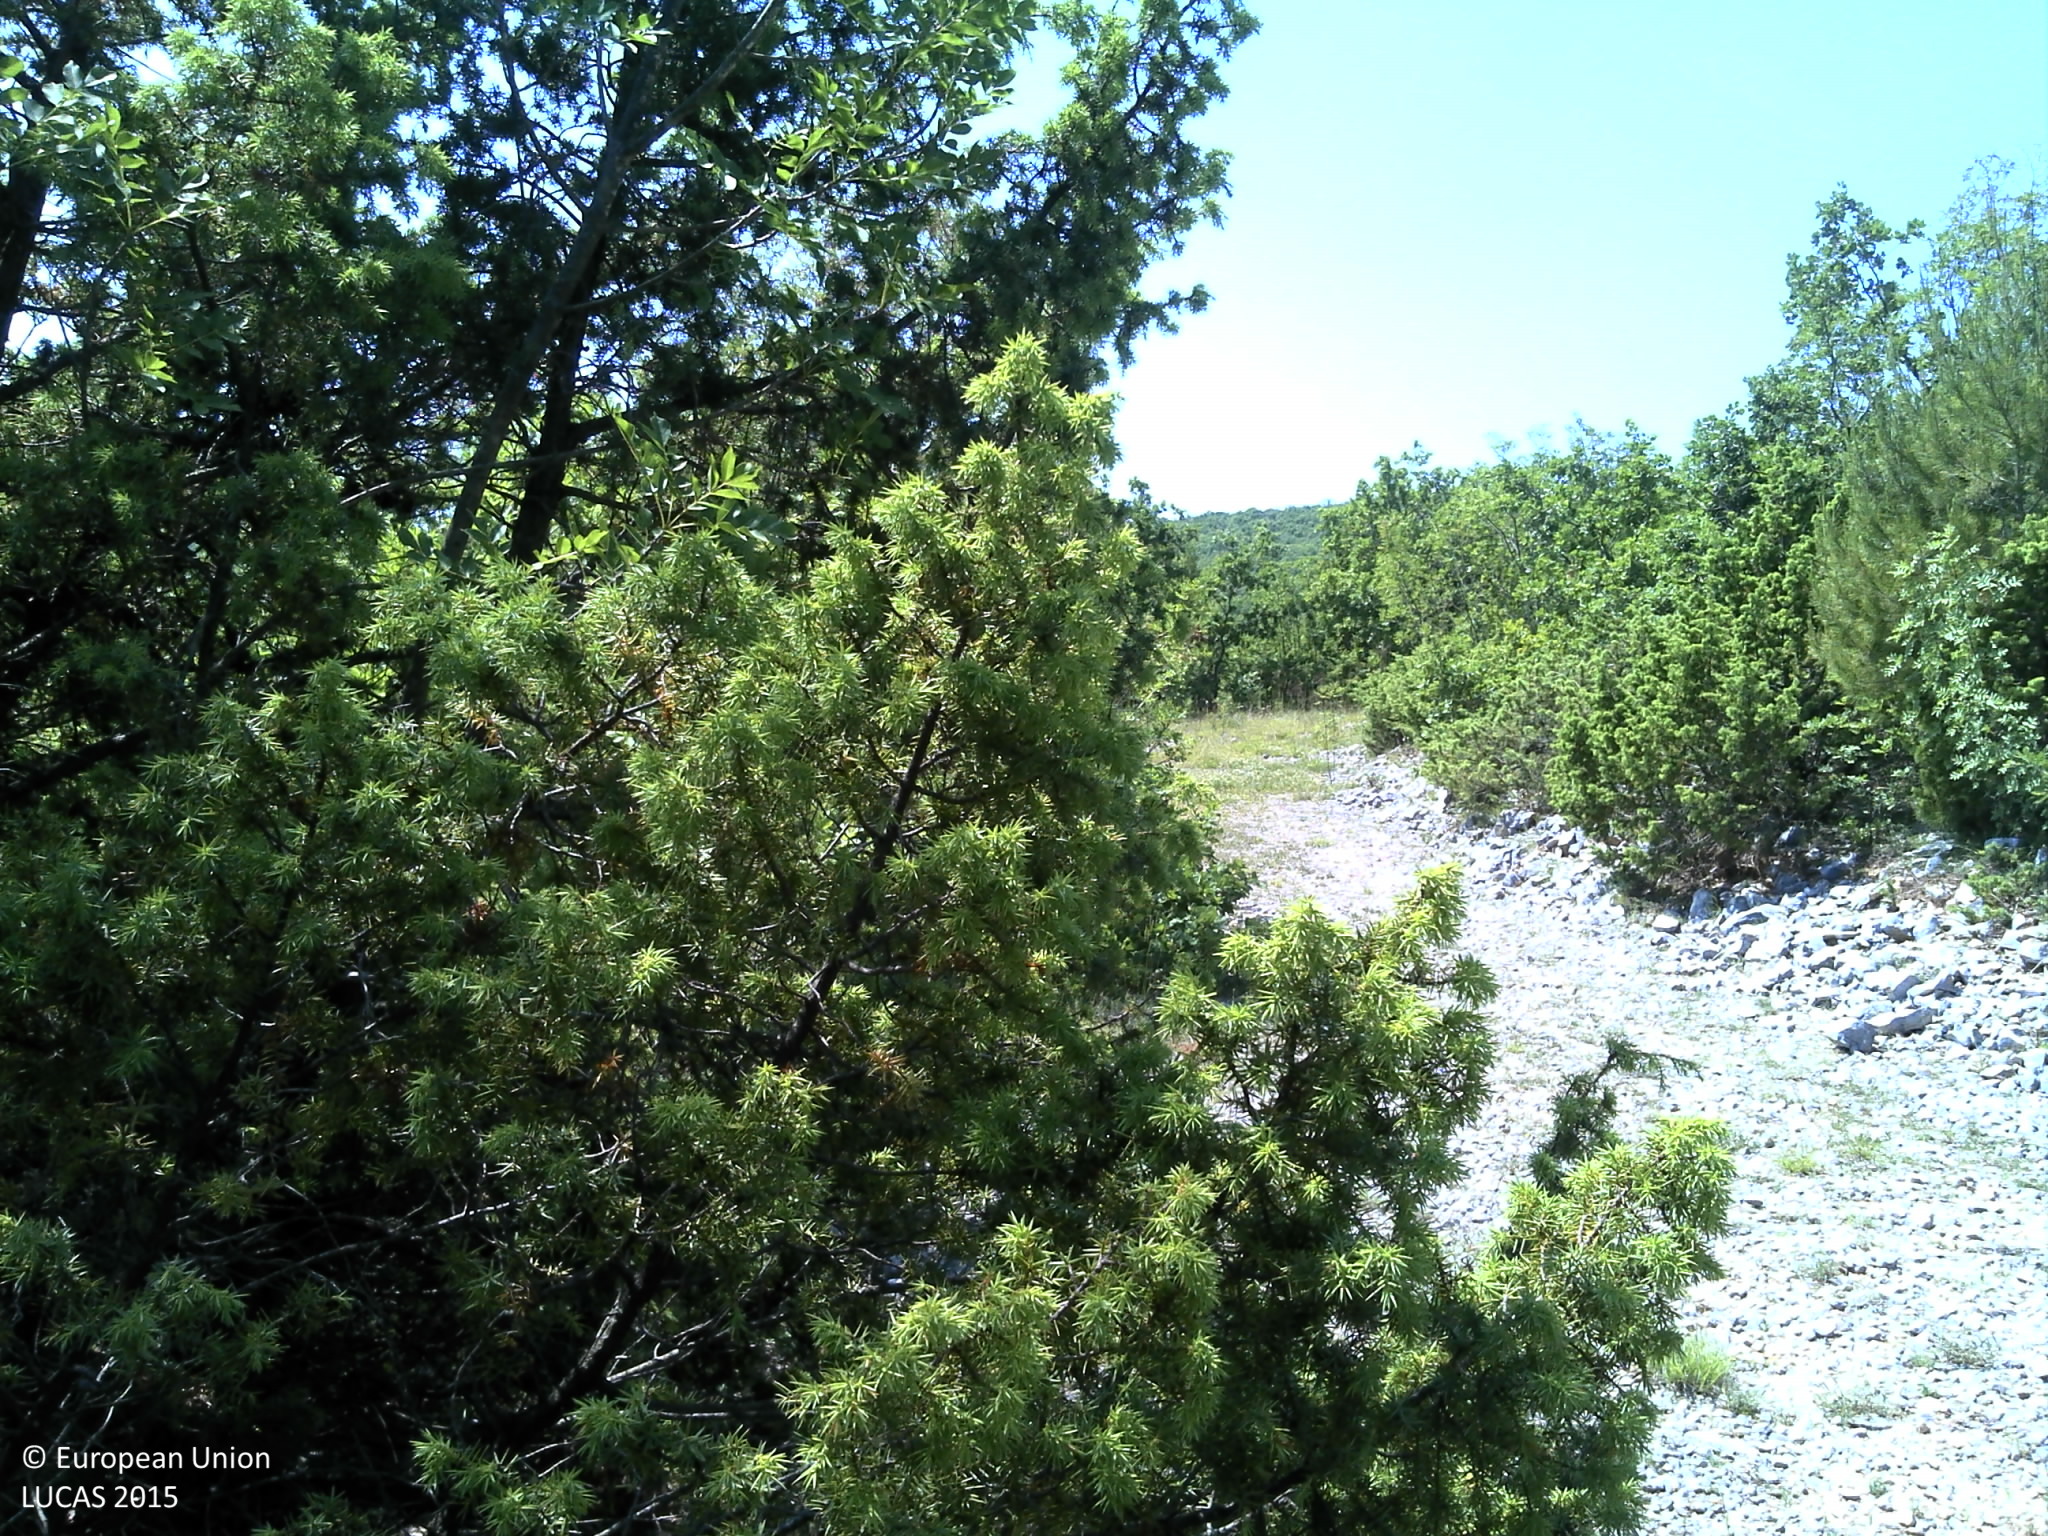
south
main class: Woodland
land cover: Broadleaved woodland
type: thermophilous deciduous forest
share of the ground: 50 - 75 %
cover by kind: broadleaved forest trees 60 %, shrubs 25 %, unconsolidated bare surface 10 %, consolidated bare surface 5 %
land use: Semi-natural and natural areas not in use
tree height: > 5 m
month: June
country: HR
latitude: 43.6015
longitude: 16.2470
